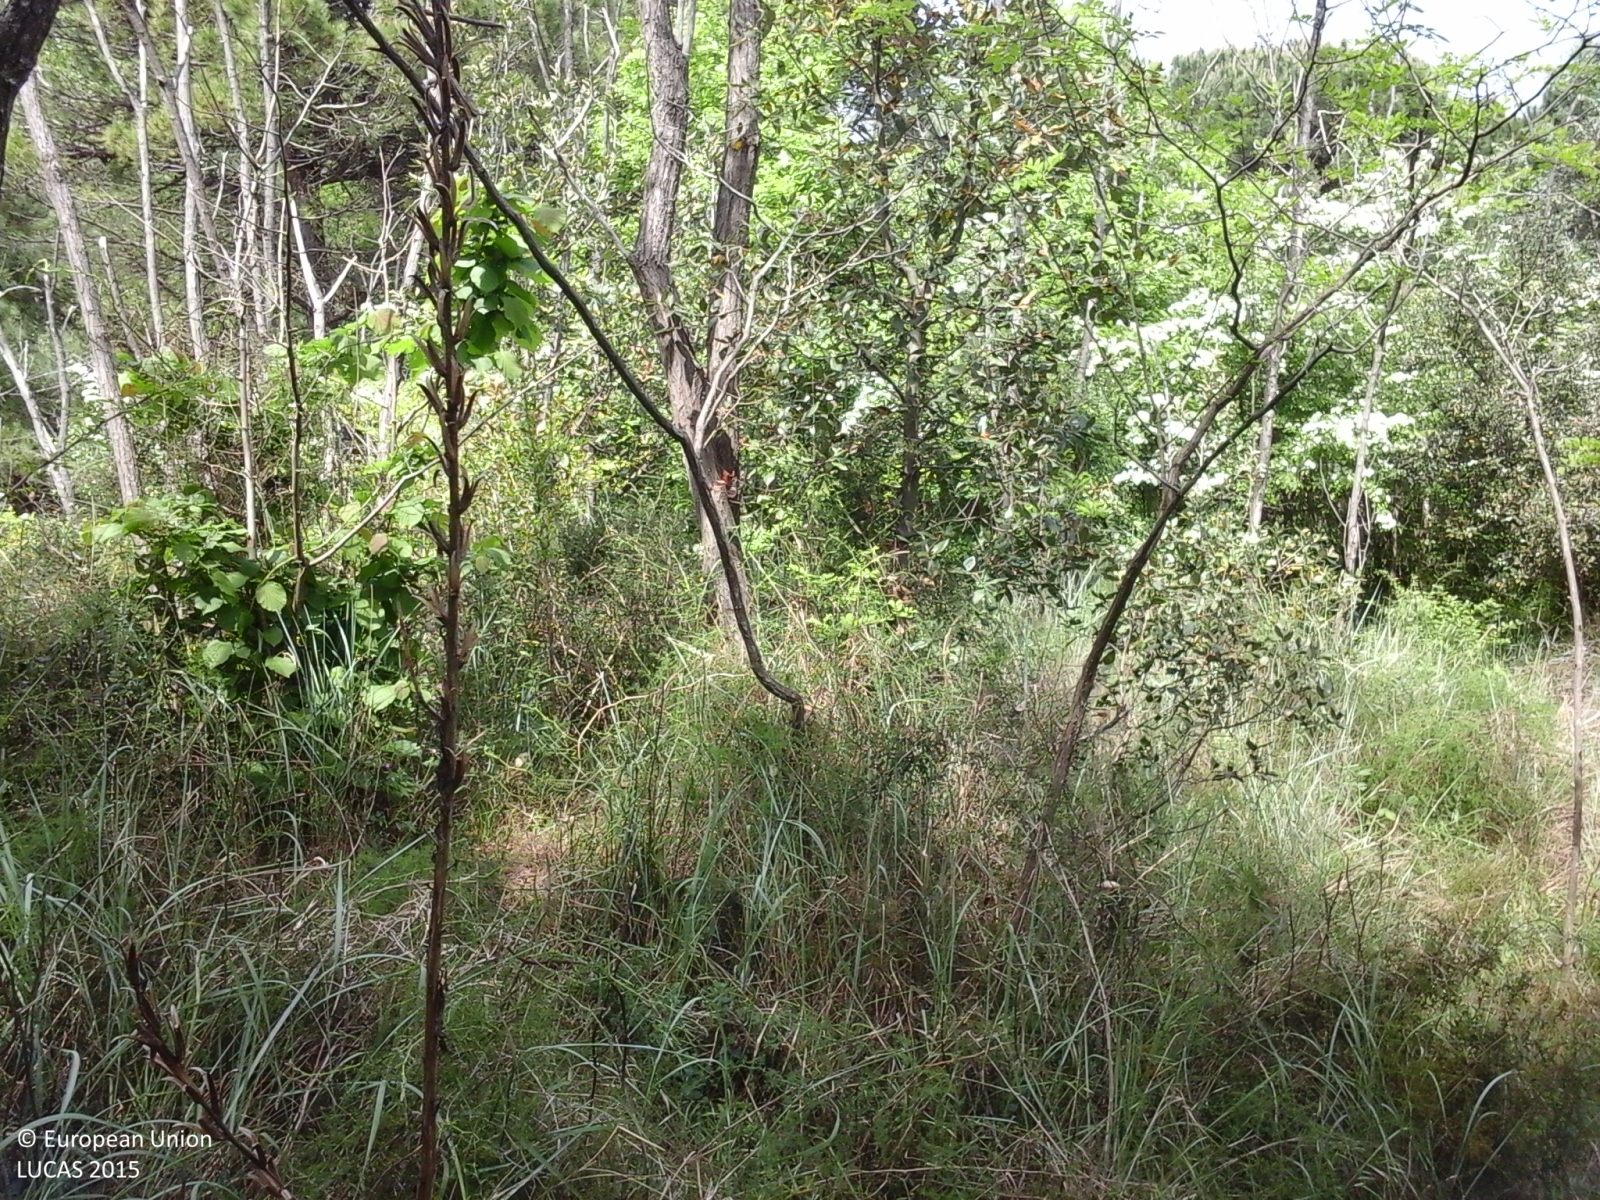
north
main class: Woodland
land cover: Pine dominated mixed woodland
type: coniferous forest of the mediterranean region
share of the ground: > 75 %
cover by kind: coniferous forest trees 40 %, broadleaved forest trees 20 %, shrubs 20 %, herbaceous plants 20 %
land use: Amenities, museums, leisure
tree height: > 5 m
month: May
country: IT
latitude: 45.5241
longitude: 12.6975
